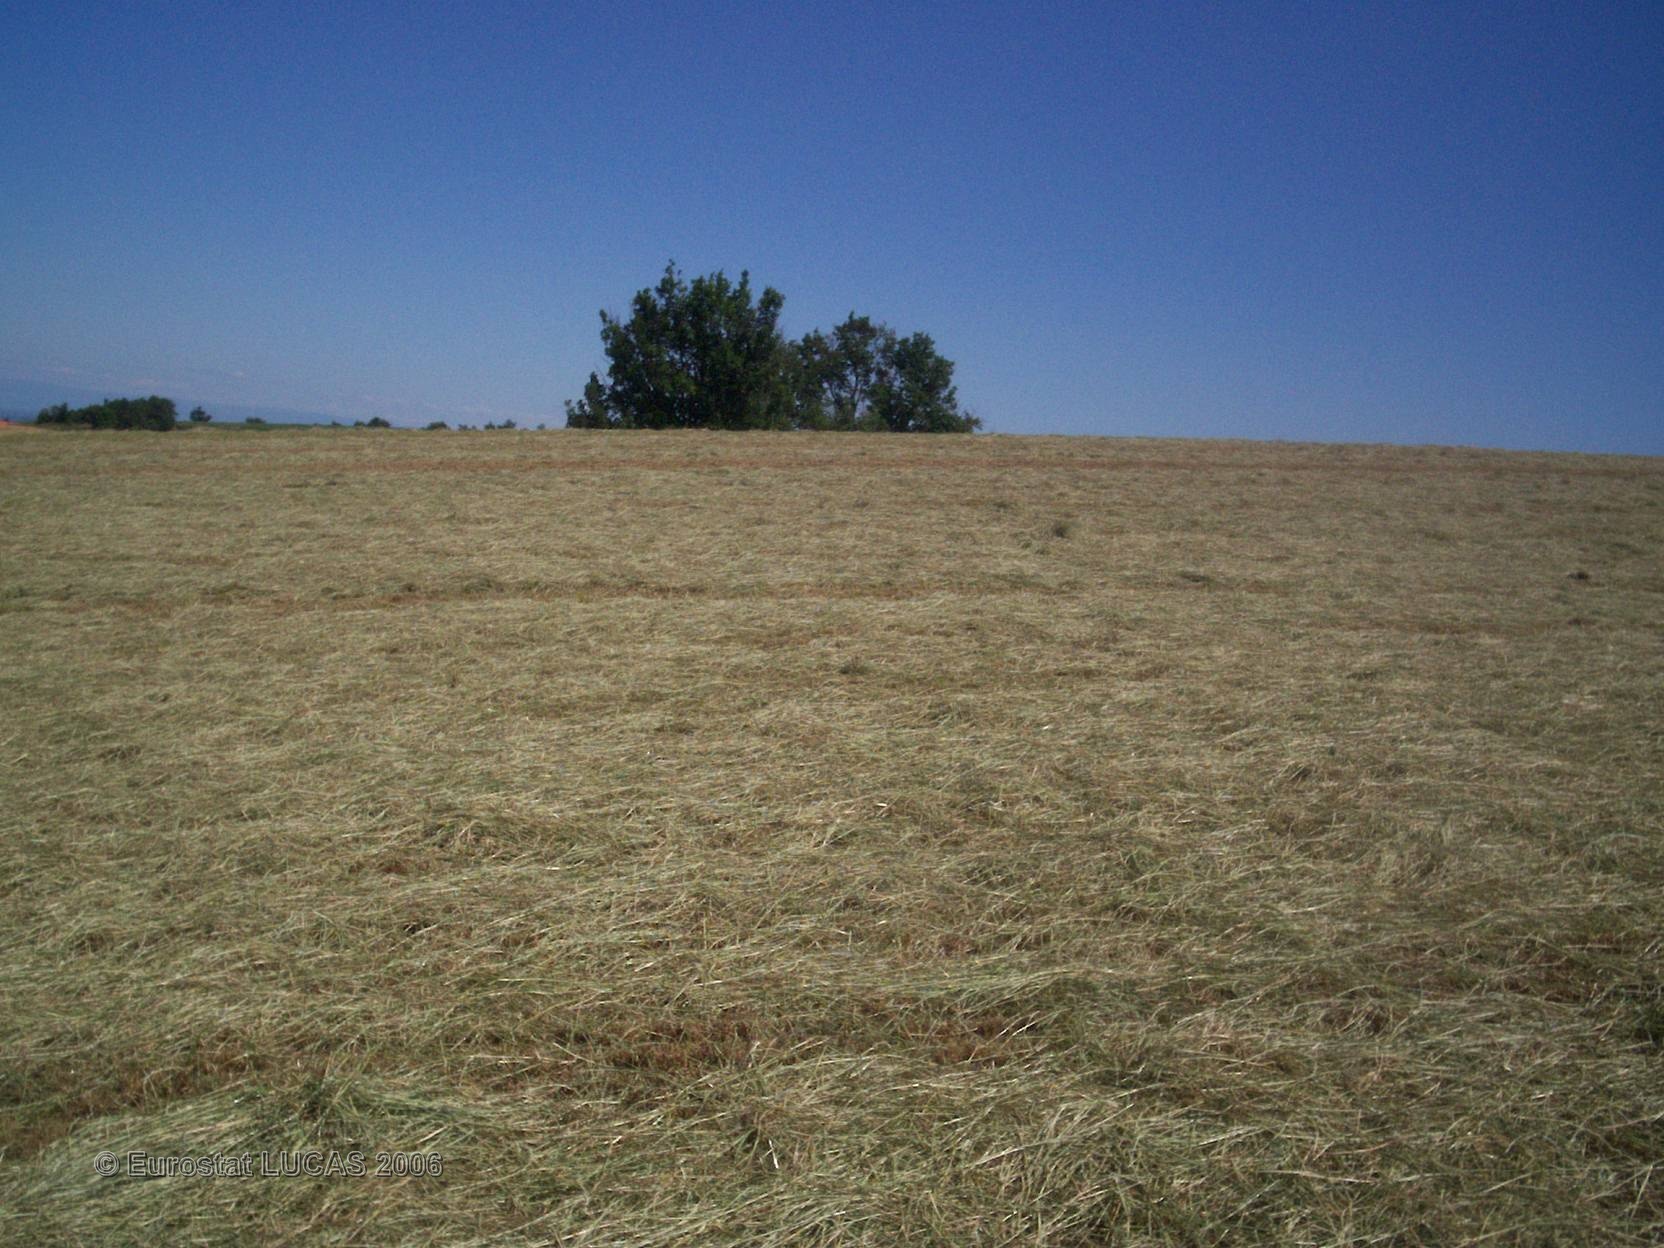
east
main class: Cropland
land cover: Durum wheat
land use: Agriculture (excluding fallow land and kitchen gardens)
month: May
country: FR
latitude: 45.0506
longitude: 4.7868
